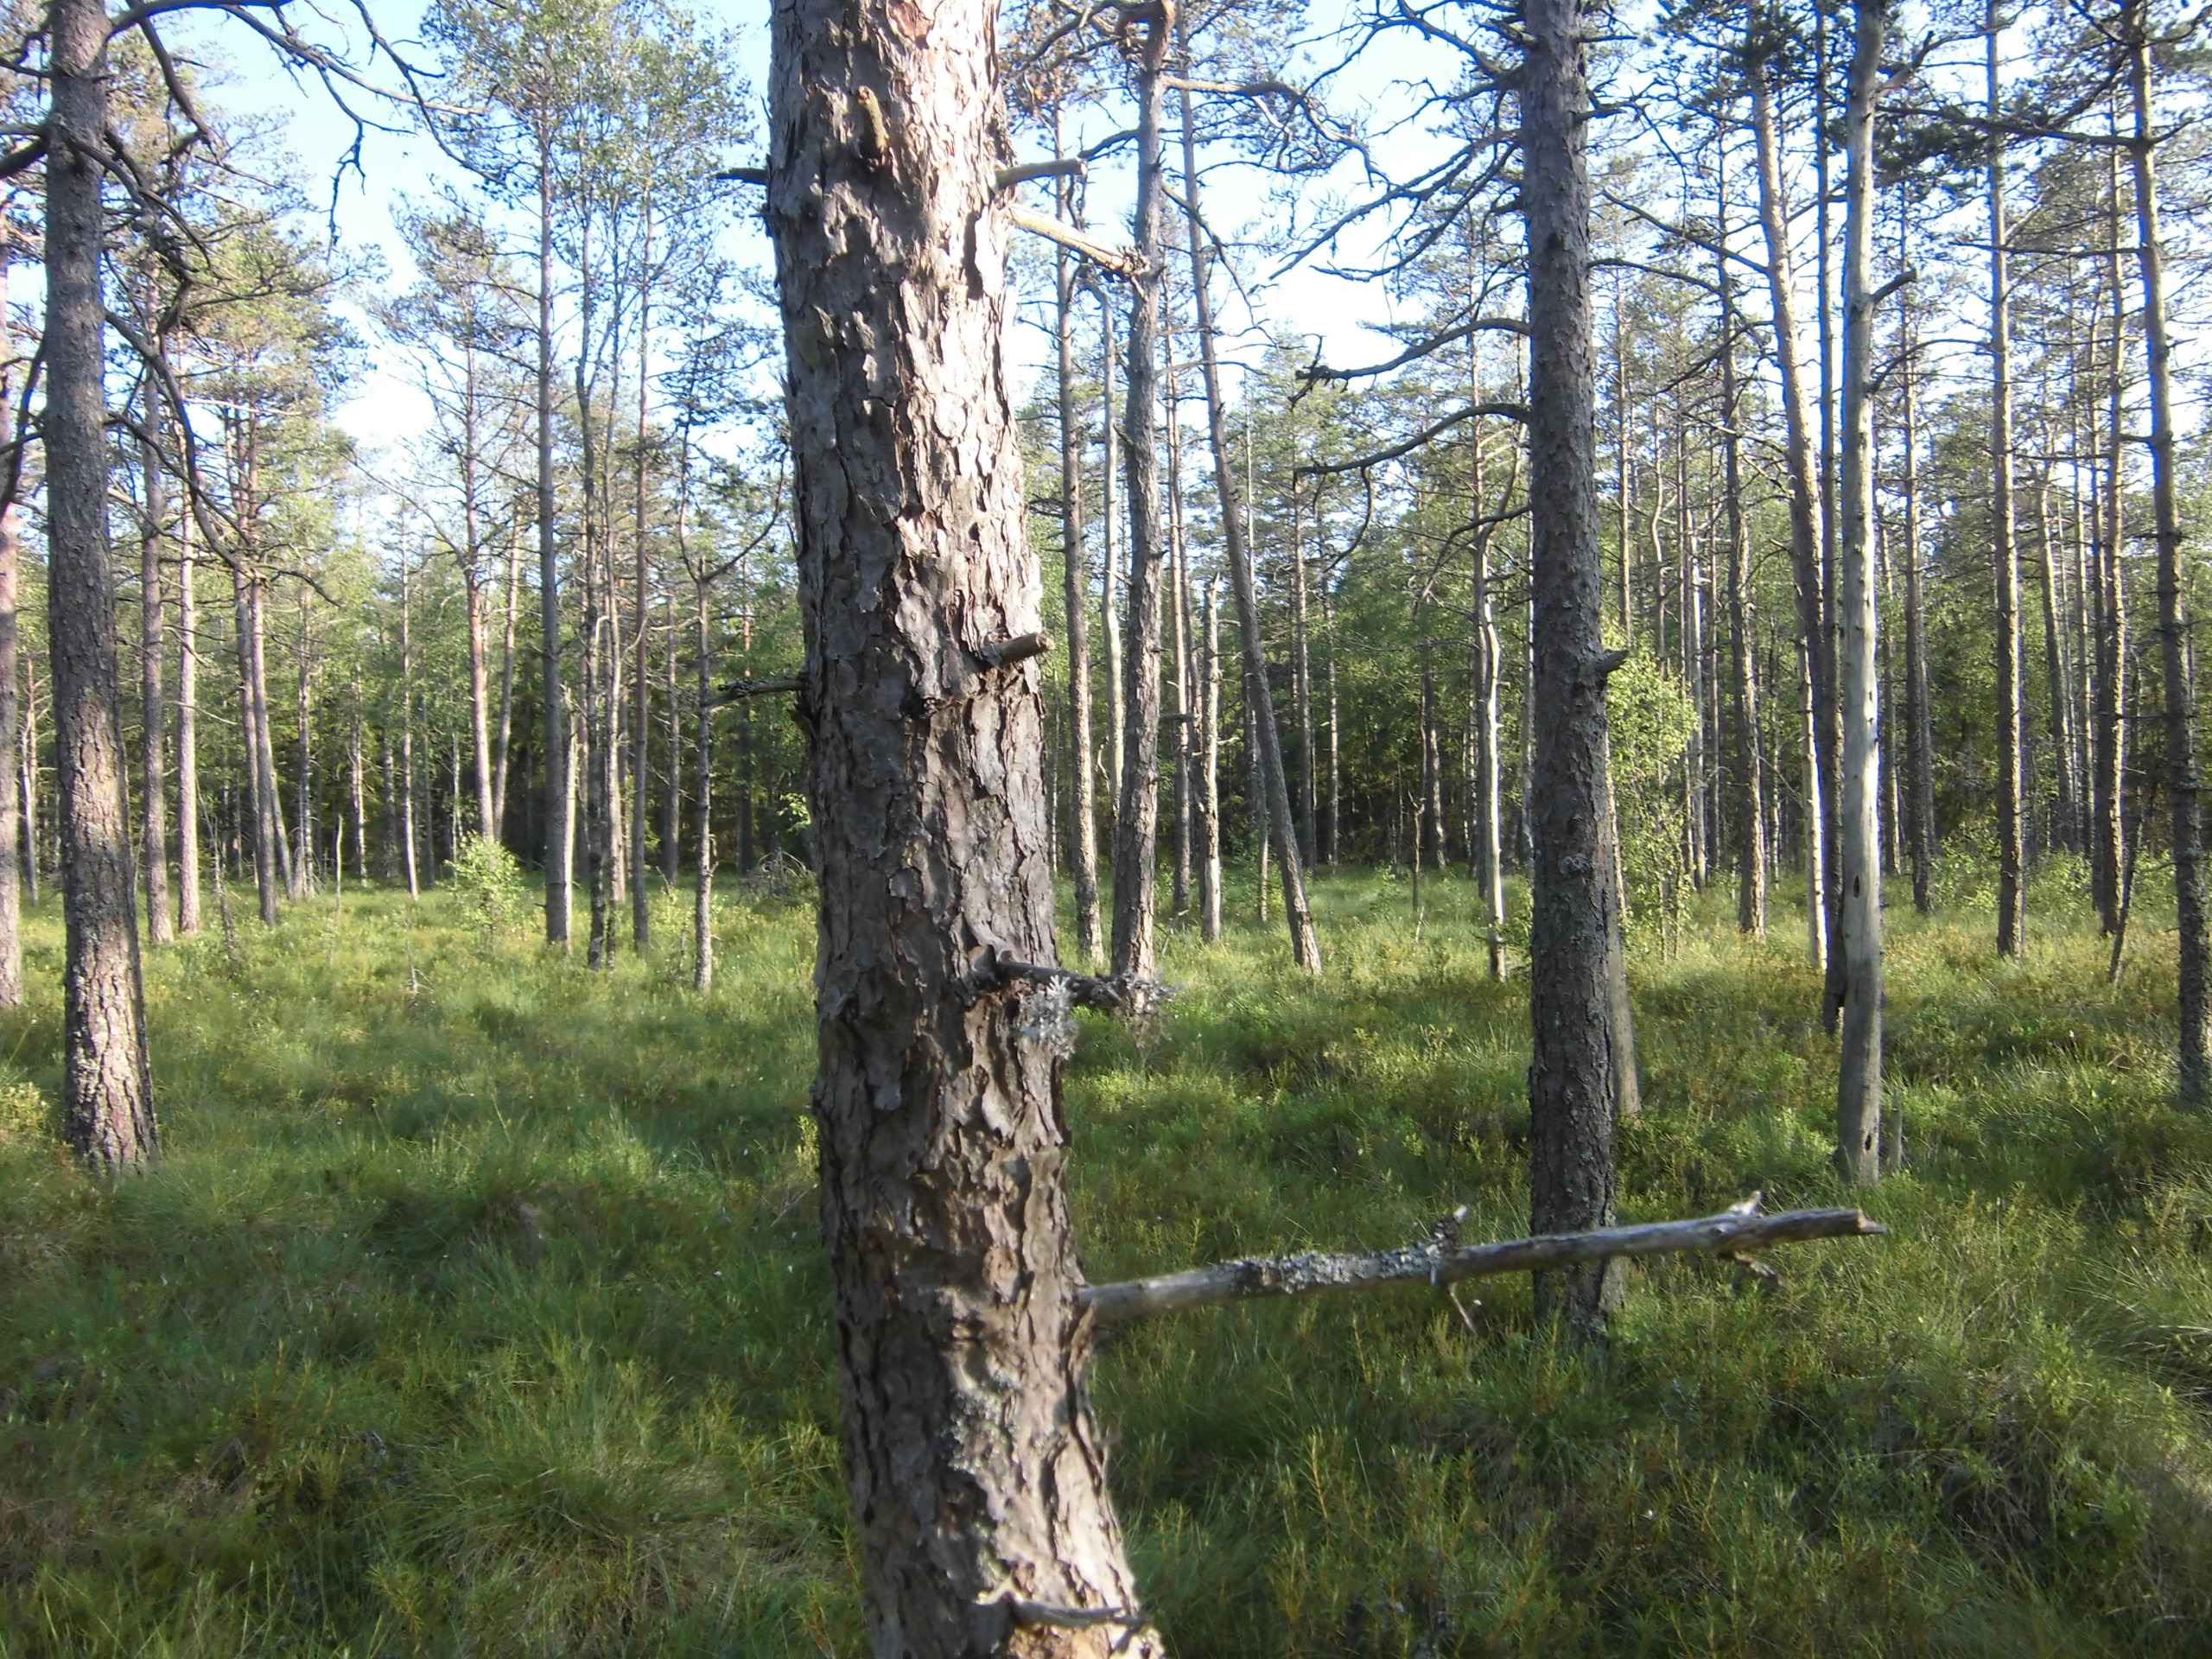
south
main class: Woodland
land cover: Pine dominated coniferous woodland
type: boreal forest
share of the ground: 50 - 75 %
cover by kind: coniferous forest trees 50 %, shrubs 15 %, herbaceous plants 15 %, lichens and mosses 15 %, broadleaved forest trees 5 %
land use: Forestry
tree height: > 5 m
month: July
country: SE
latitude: 57.1800
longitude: 15.2411
